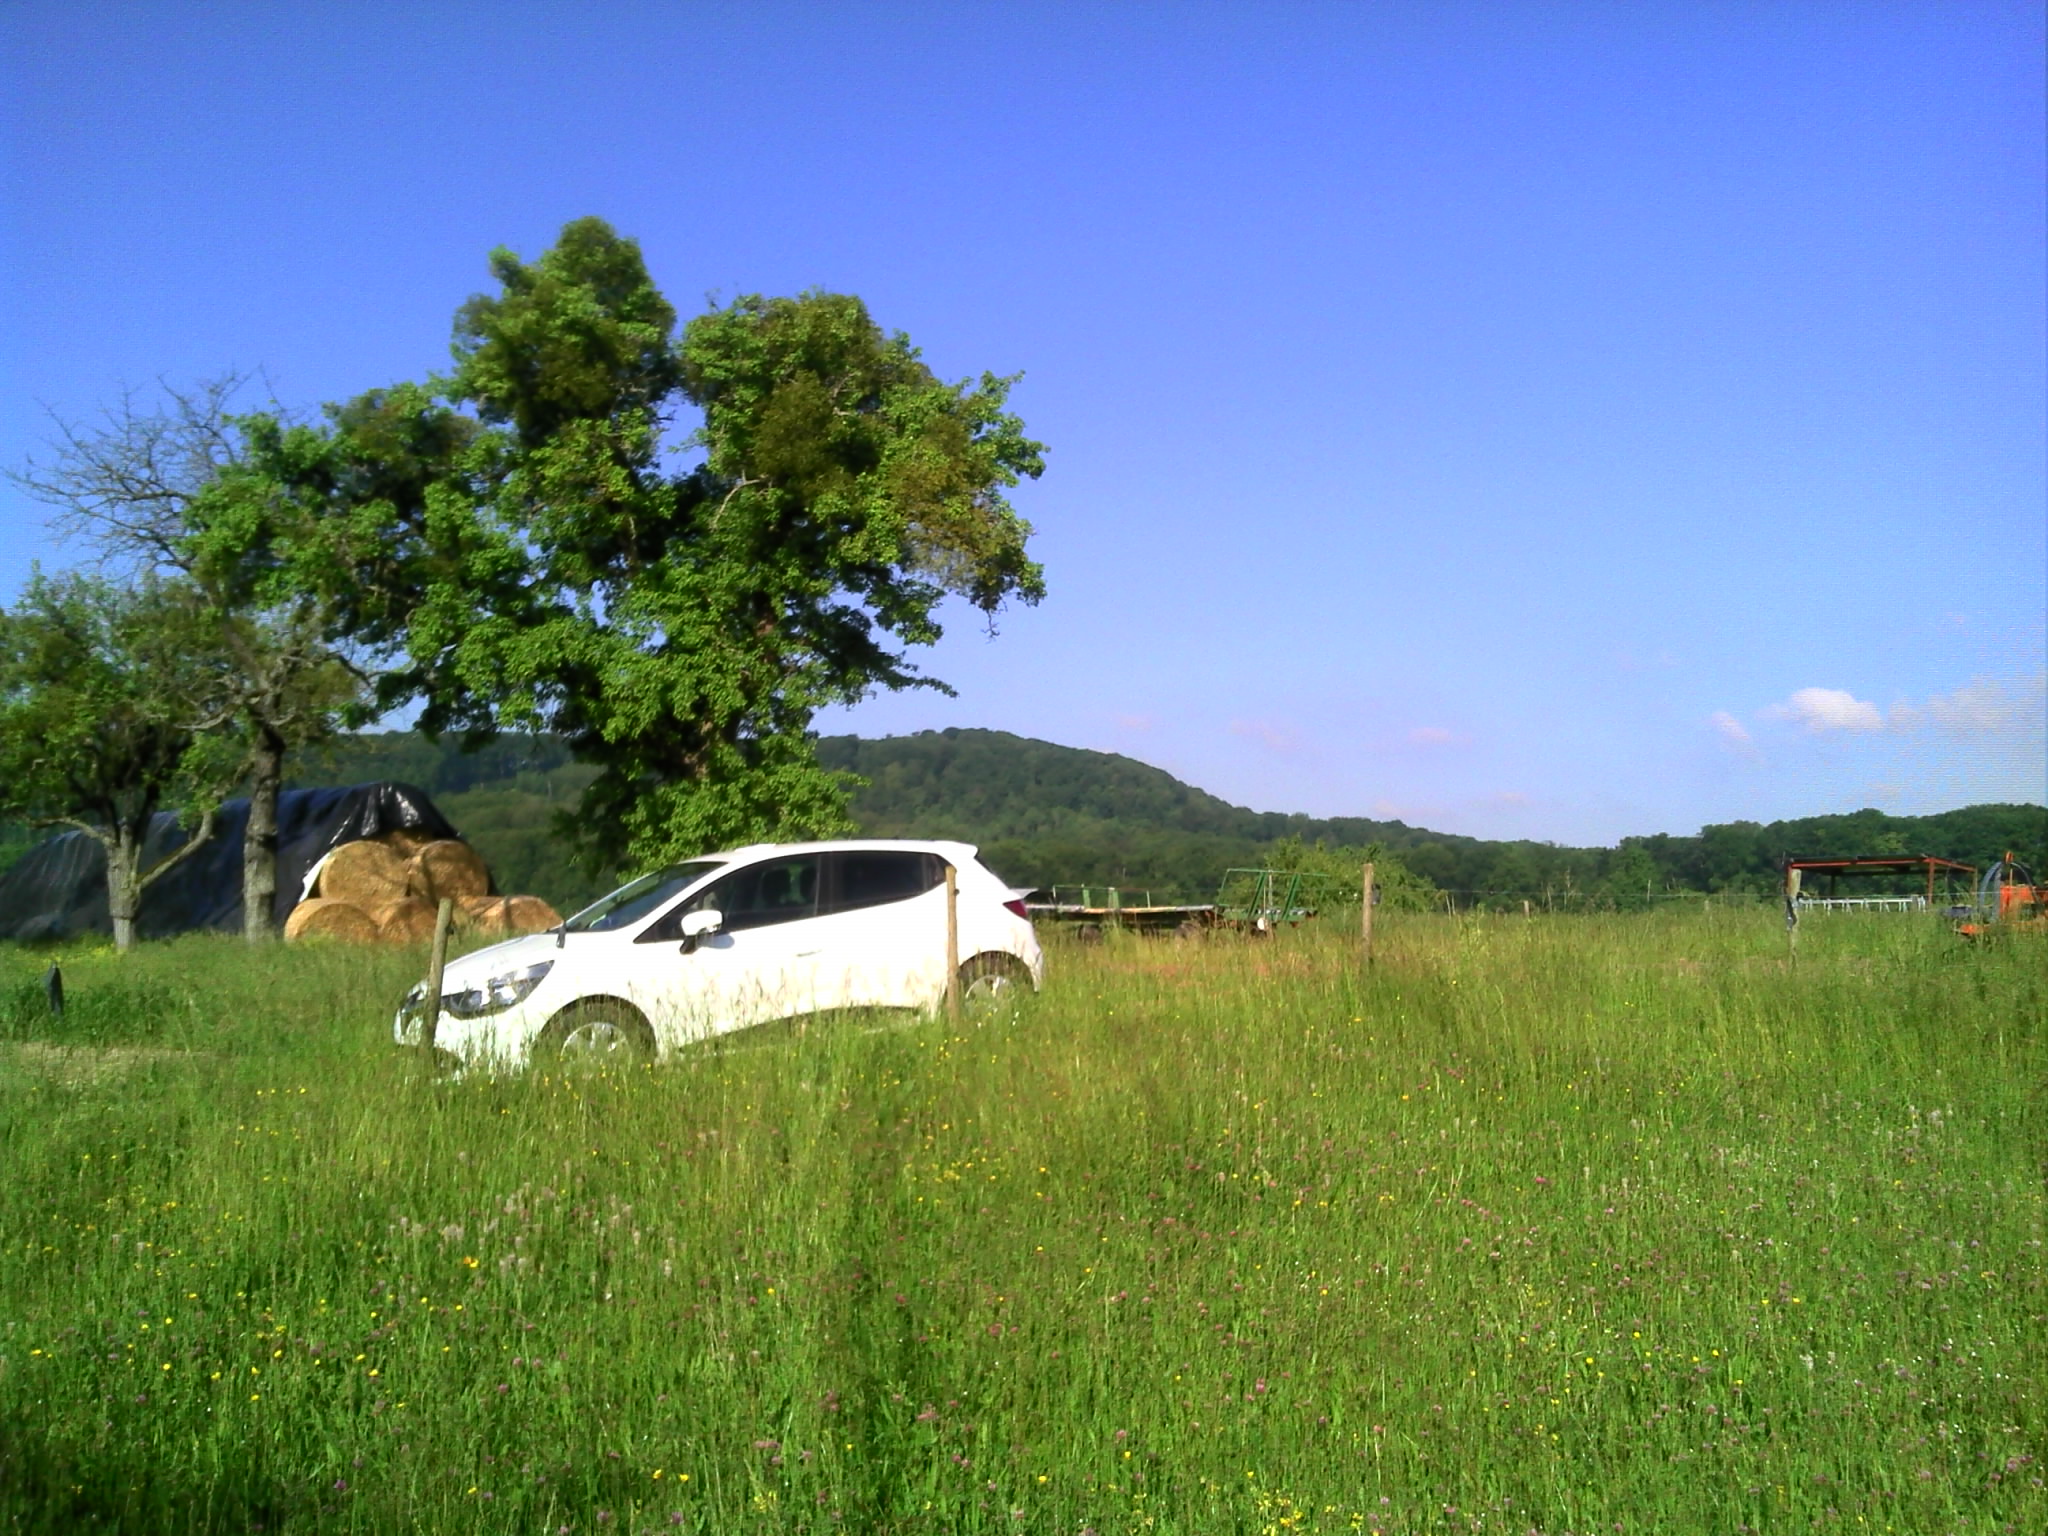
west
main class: Grassland
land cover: Grassland with sparse tree/shrub cover
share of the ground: > 75 %
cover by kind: herbaceous plants 95 %, broadleaved forest trees 5 %
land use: Agriculture (excluding fallow land and kitchen gardens)
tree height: > 5 m
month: May
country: LU
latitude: 49.5485
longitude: 6.3093
